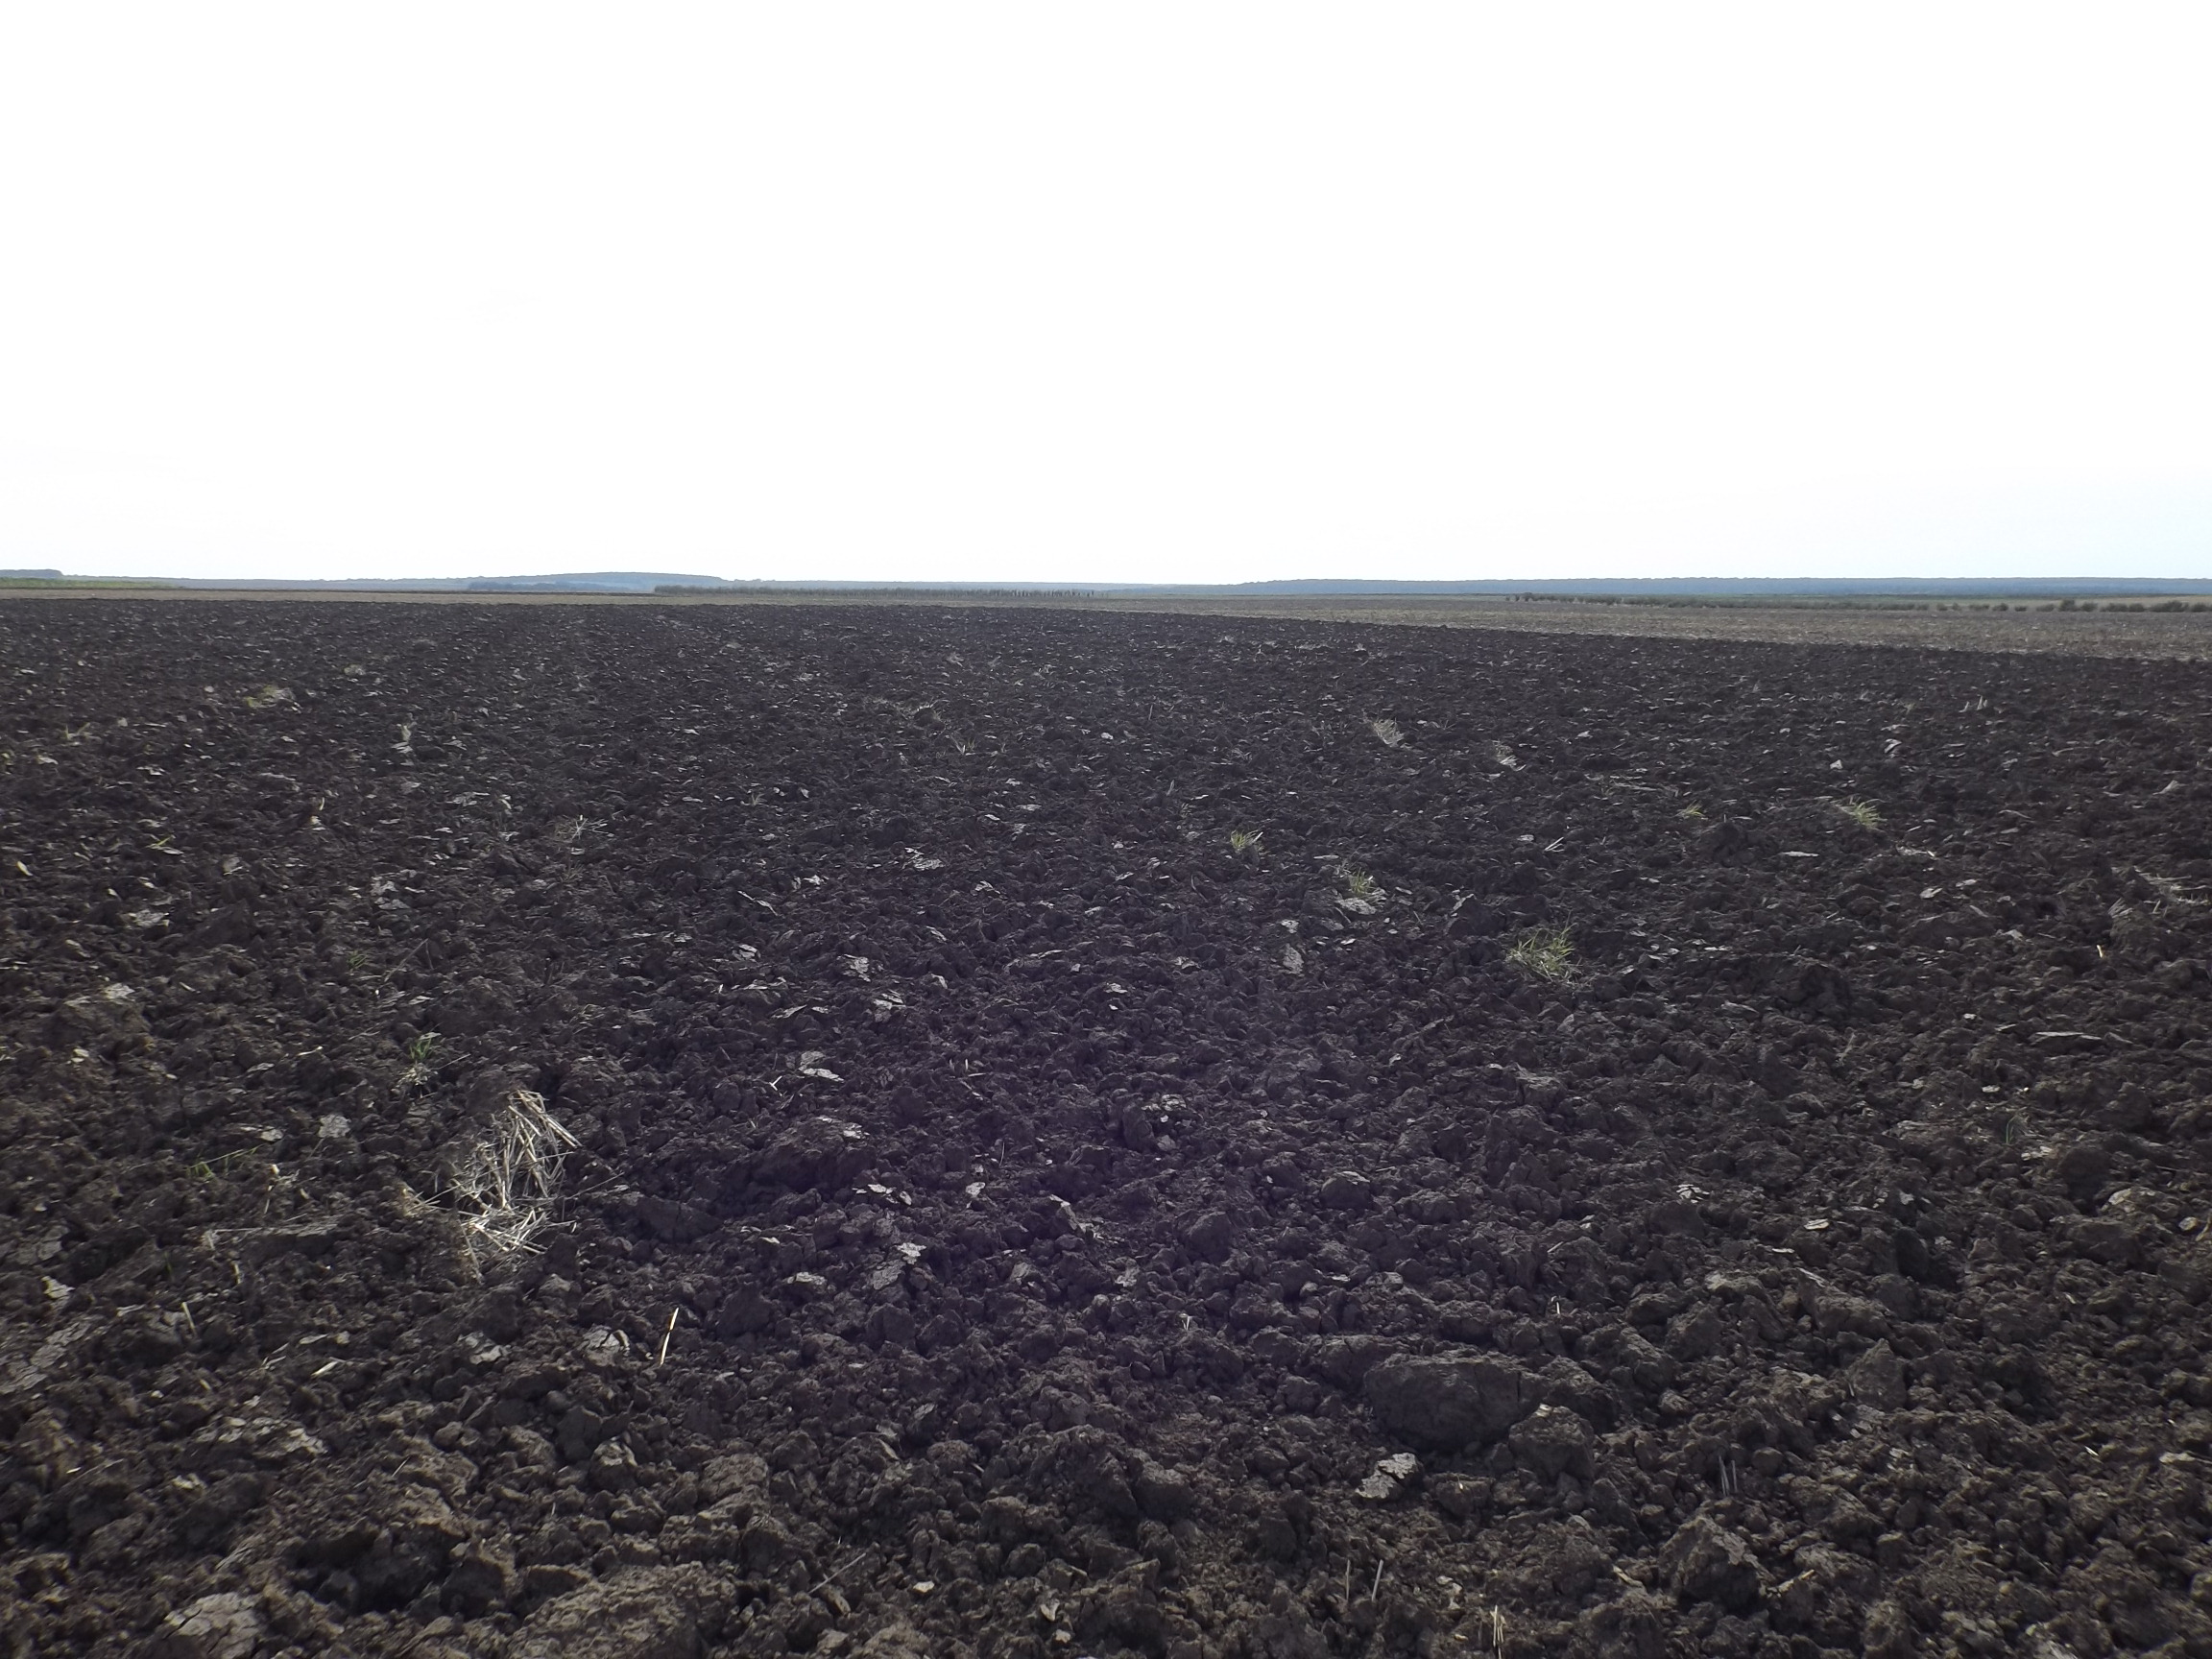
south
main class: Cropland
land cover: Common wheat
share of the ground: < 10 %
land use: Agriculture (excluding fallow land and kitchen gardens)
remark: Harvested field
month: October
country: BG
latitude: 43.9046
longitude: 26.8140
